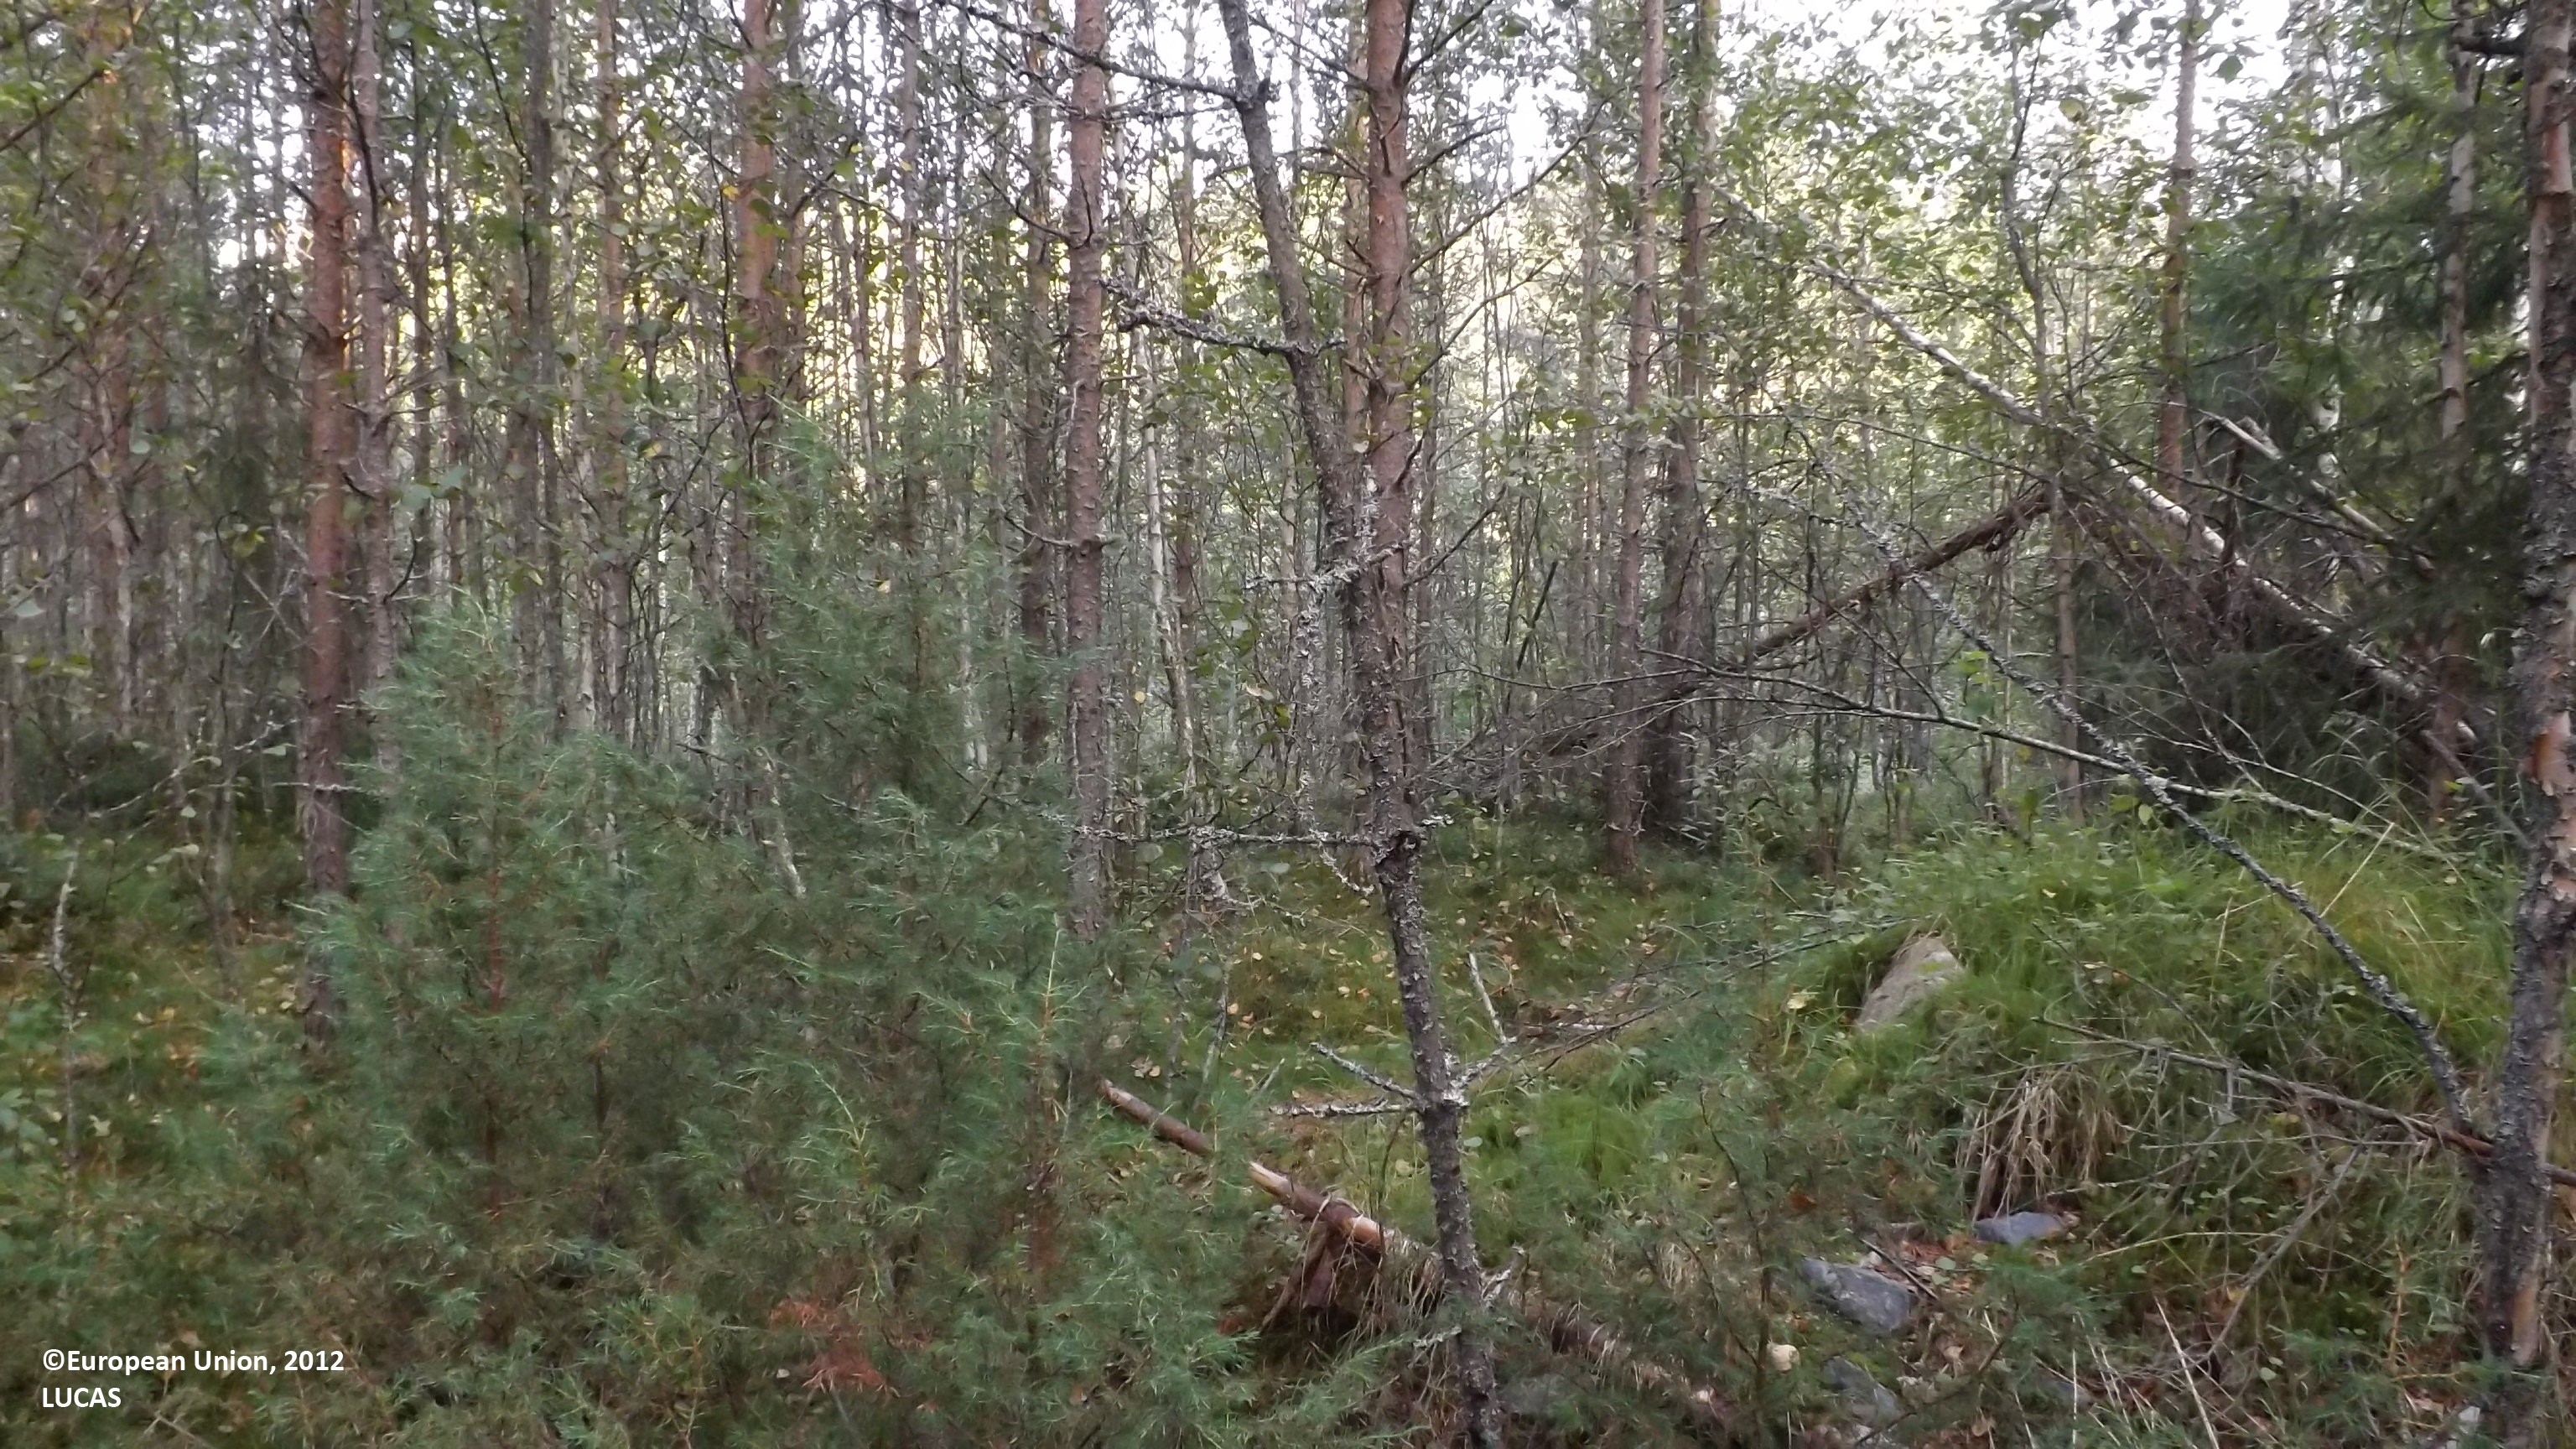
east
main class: Woodland
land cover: Other mixed woodland
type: boreal forest
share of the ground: > 75 %
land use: Forestry
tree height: > 5 m
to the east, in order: Other mixed woodland; Ditches and canals; Tracks; Other mixed woodland; Inland running water; Other mixed woodland; Pine dominated mixed woodland; Other mixed woodland; Ditches and canals; Other mixed woodland
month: August
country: FI
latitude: 63.7382
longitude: 23.9841
